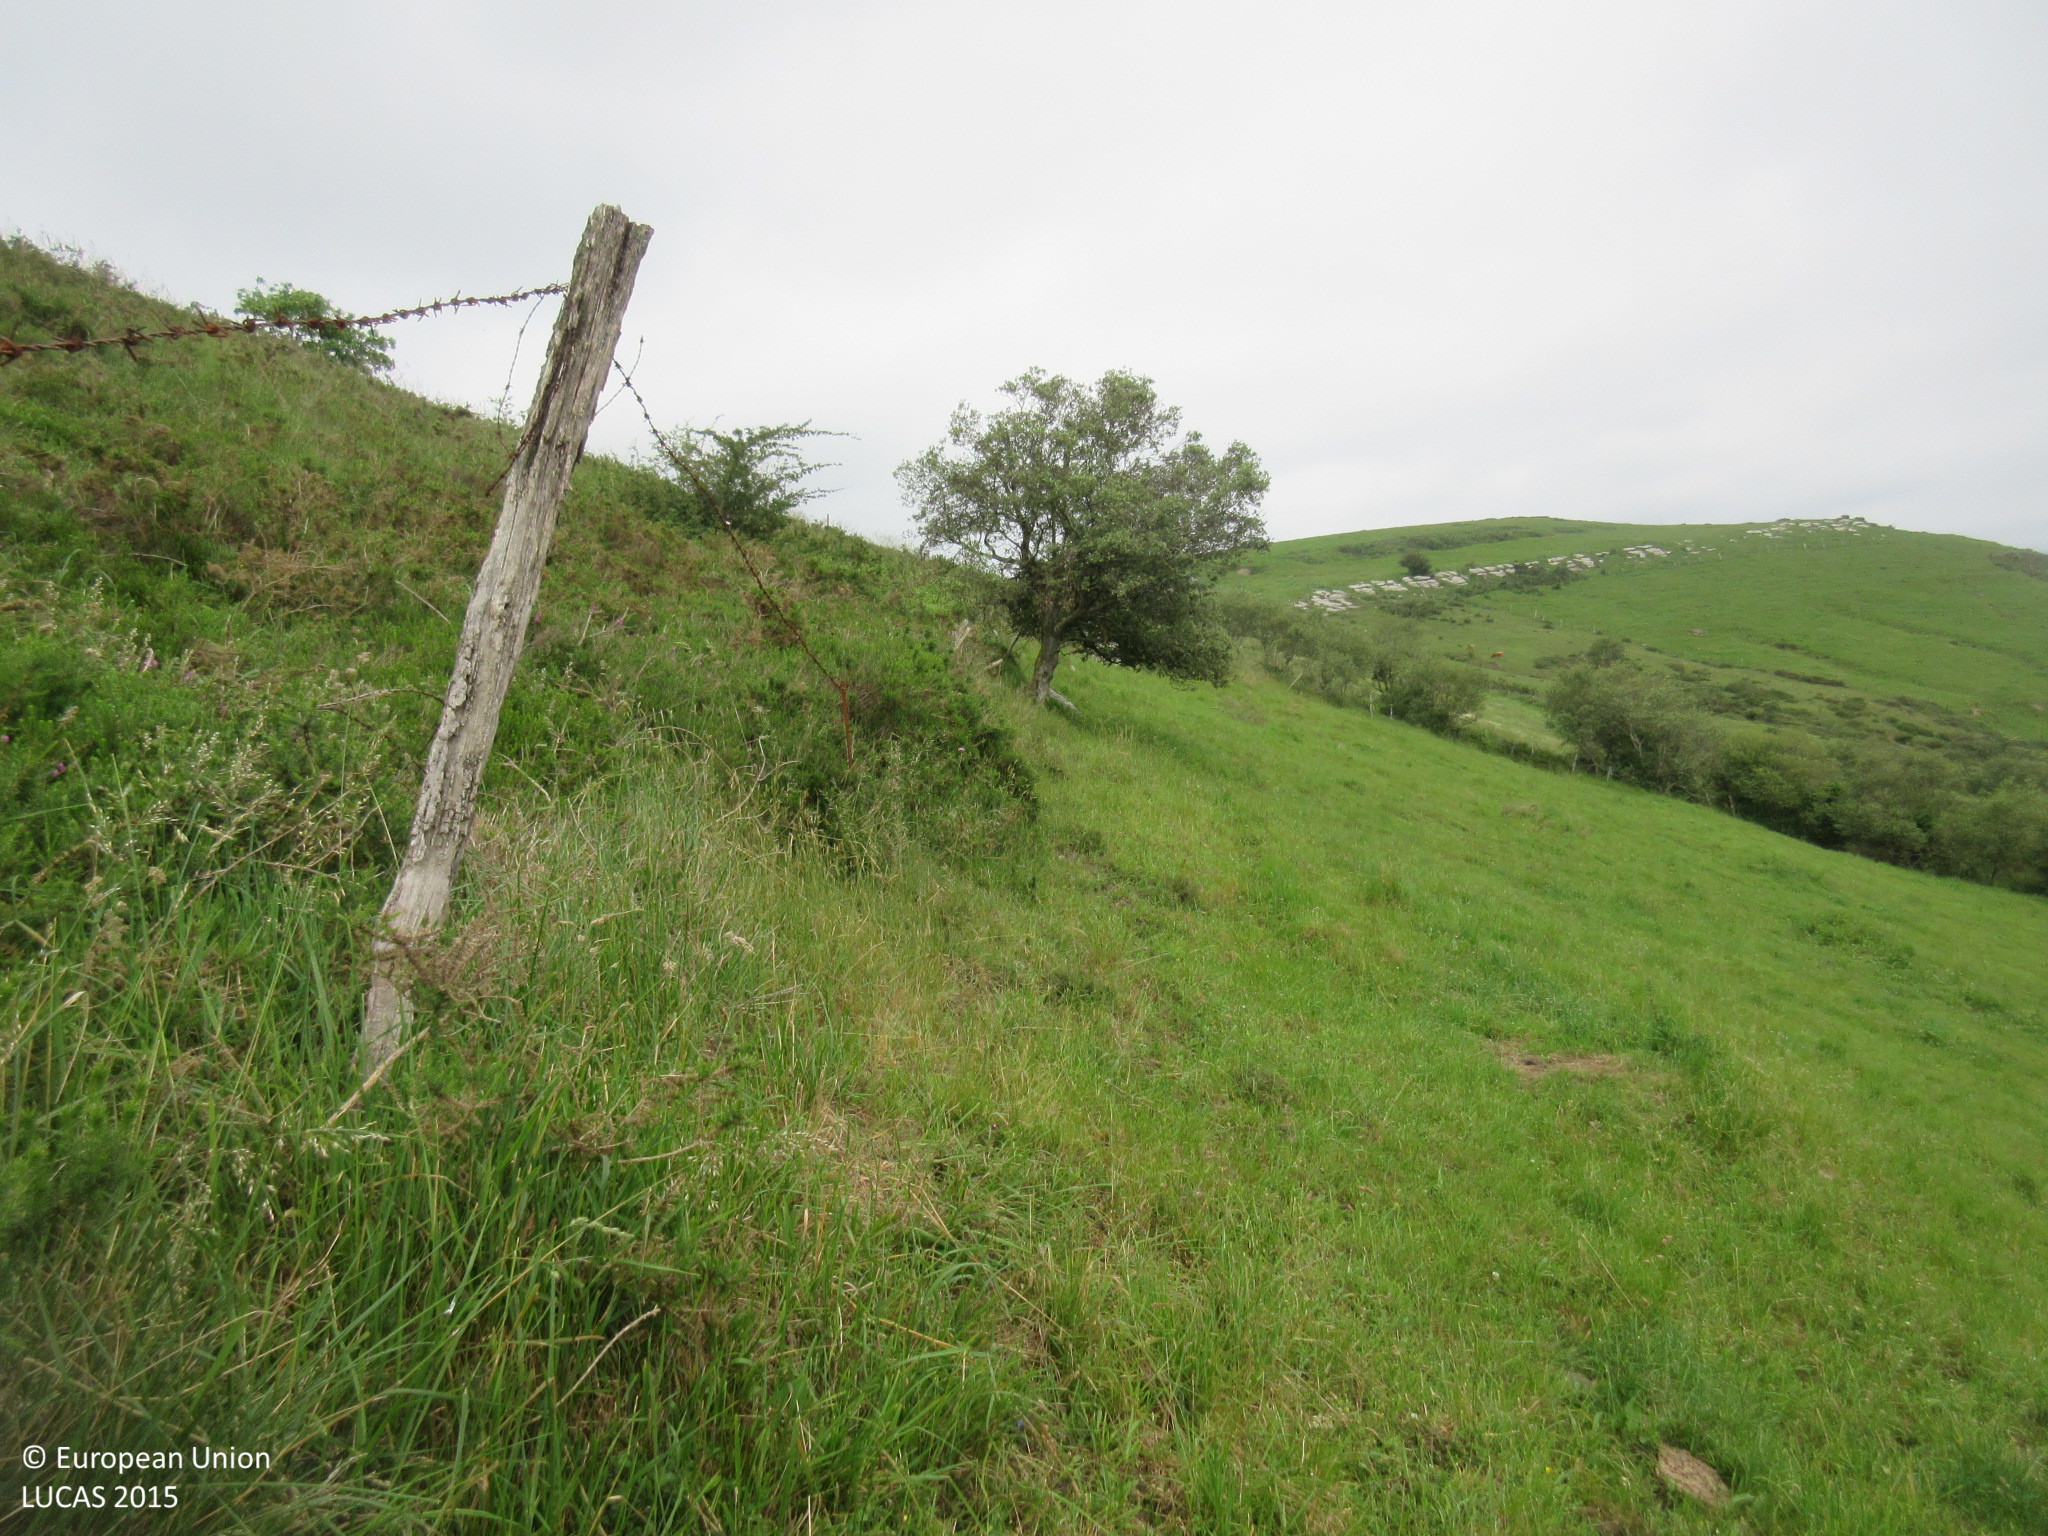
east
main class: Shrubland
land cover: Shrubland without tree cover
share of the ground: 50 - 75 %
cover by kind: shrubs 70 %, herbaceous plants 30 %
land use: Agriculture (excluding fallow land and kitchen gardens)
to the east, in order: Shrubland without tree cover; Fences; Shrubland without tree cover; Grassland without tree/shrub cover
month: June
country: ES
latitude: 43.3439
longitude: -3.5767
